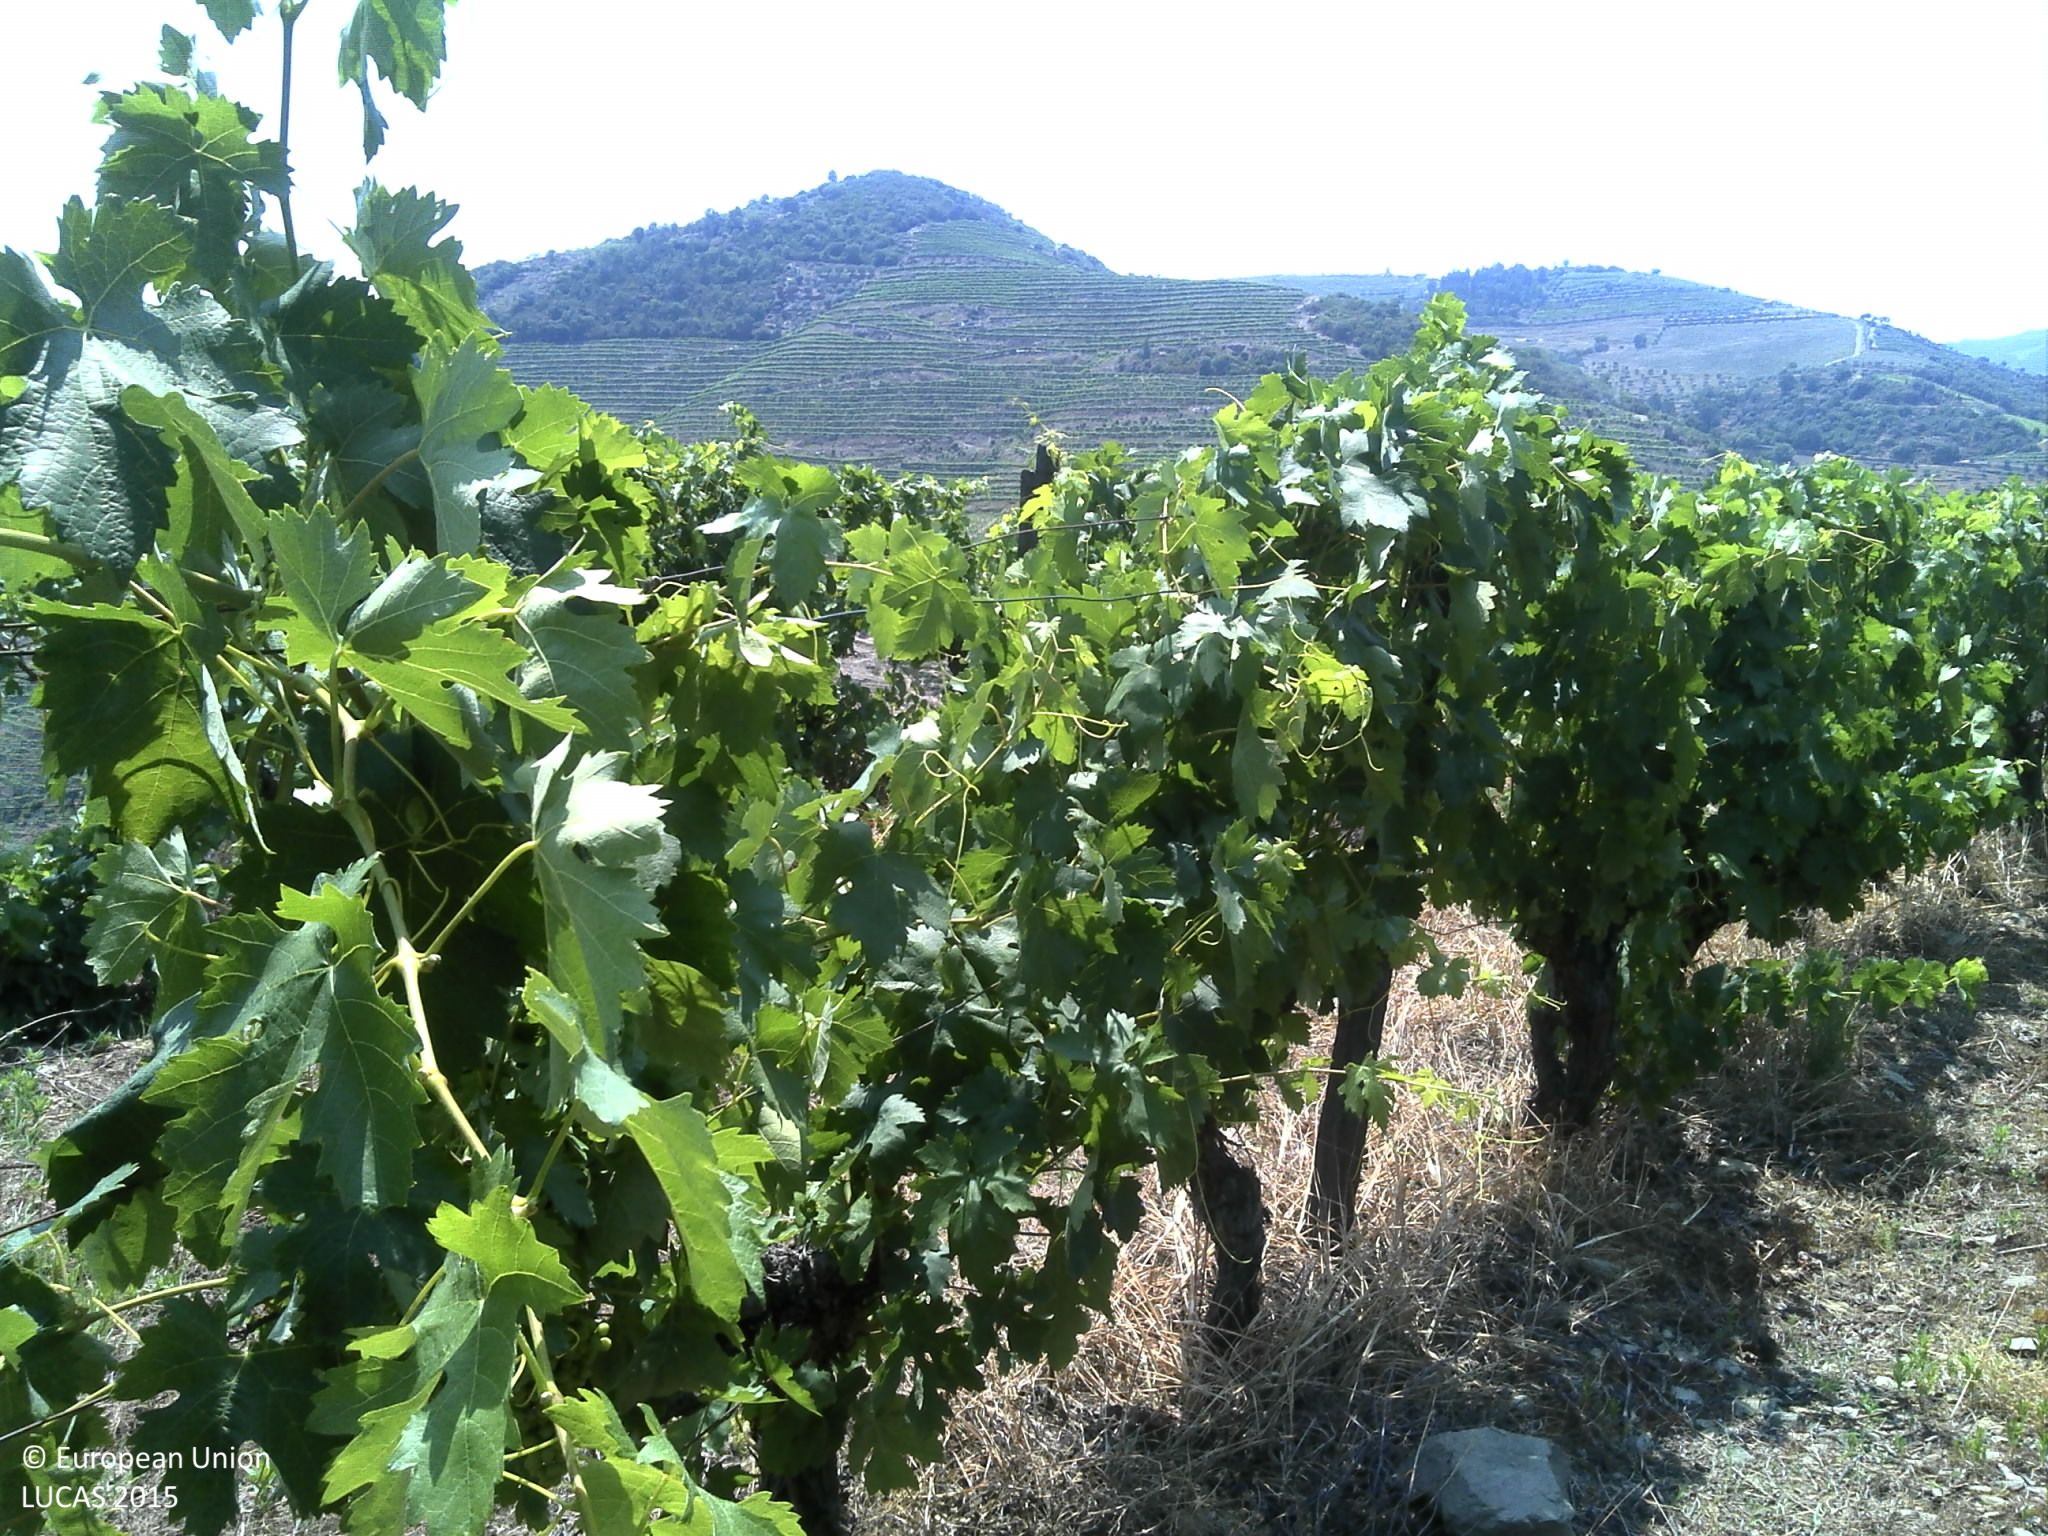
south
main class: Cropland
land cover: Vineyards
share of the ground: 10 - 25 %
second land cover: Spontaneously vegetated surfaces
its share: 10 - 25 %
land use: Agriculture (excluding fallow land and kitchen gardens)
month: June
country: PT
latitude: 41.2171
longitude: -7.4525
